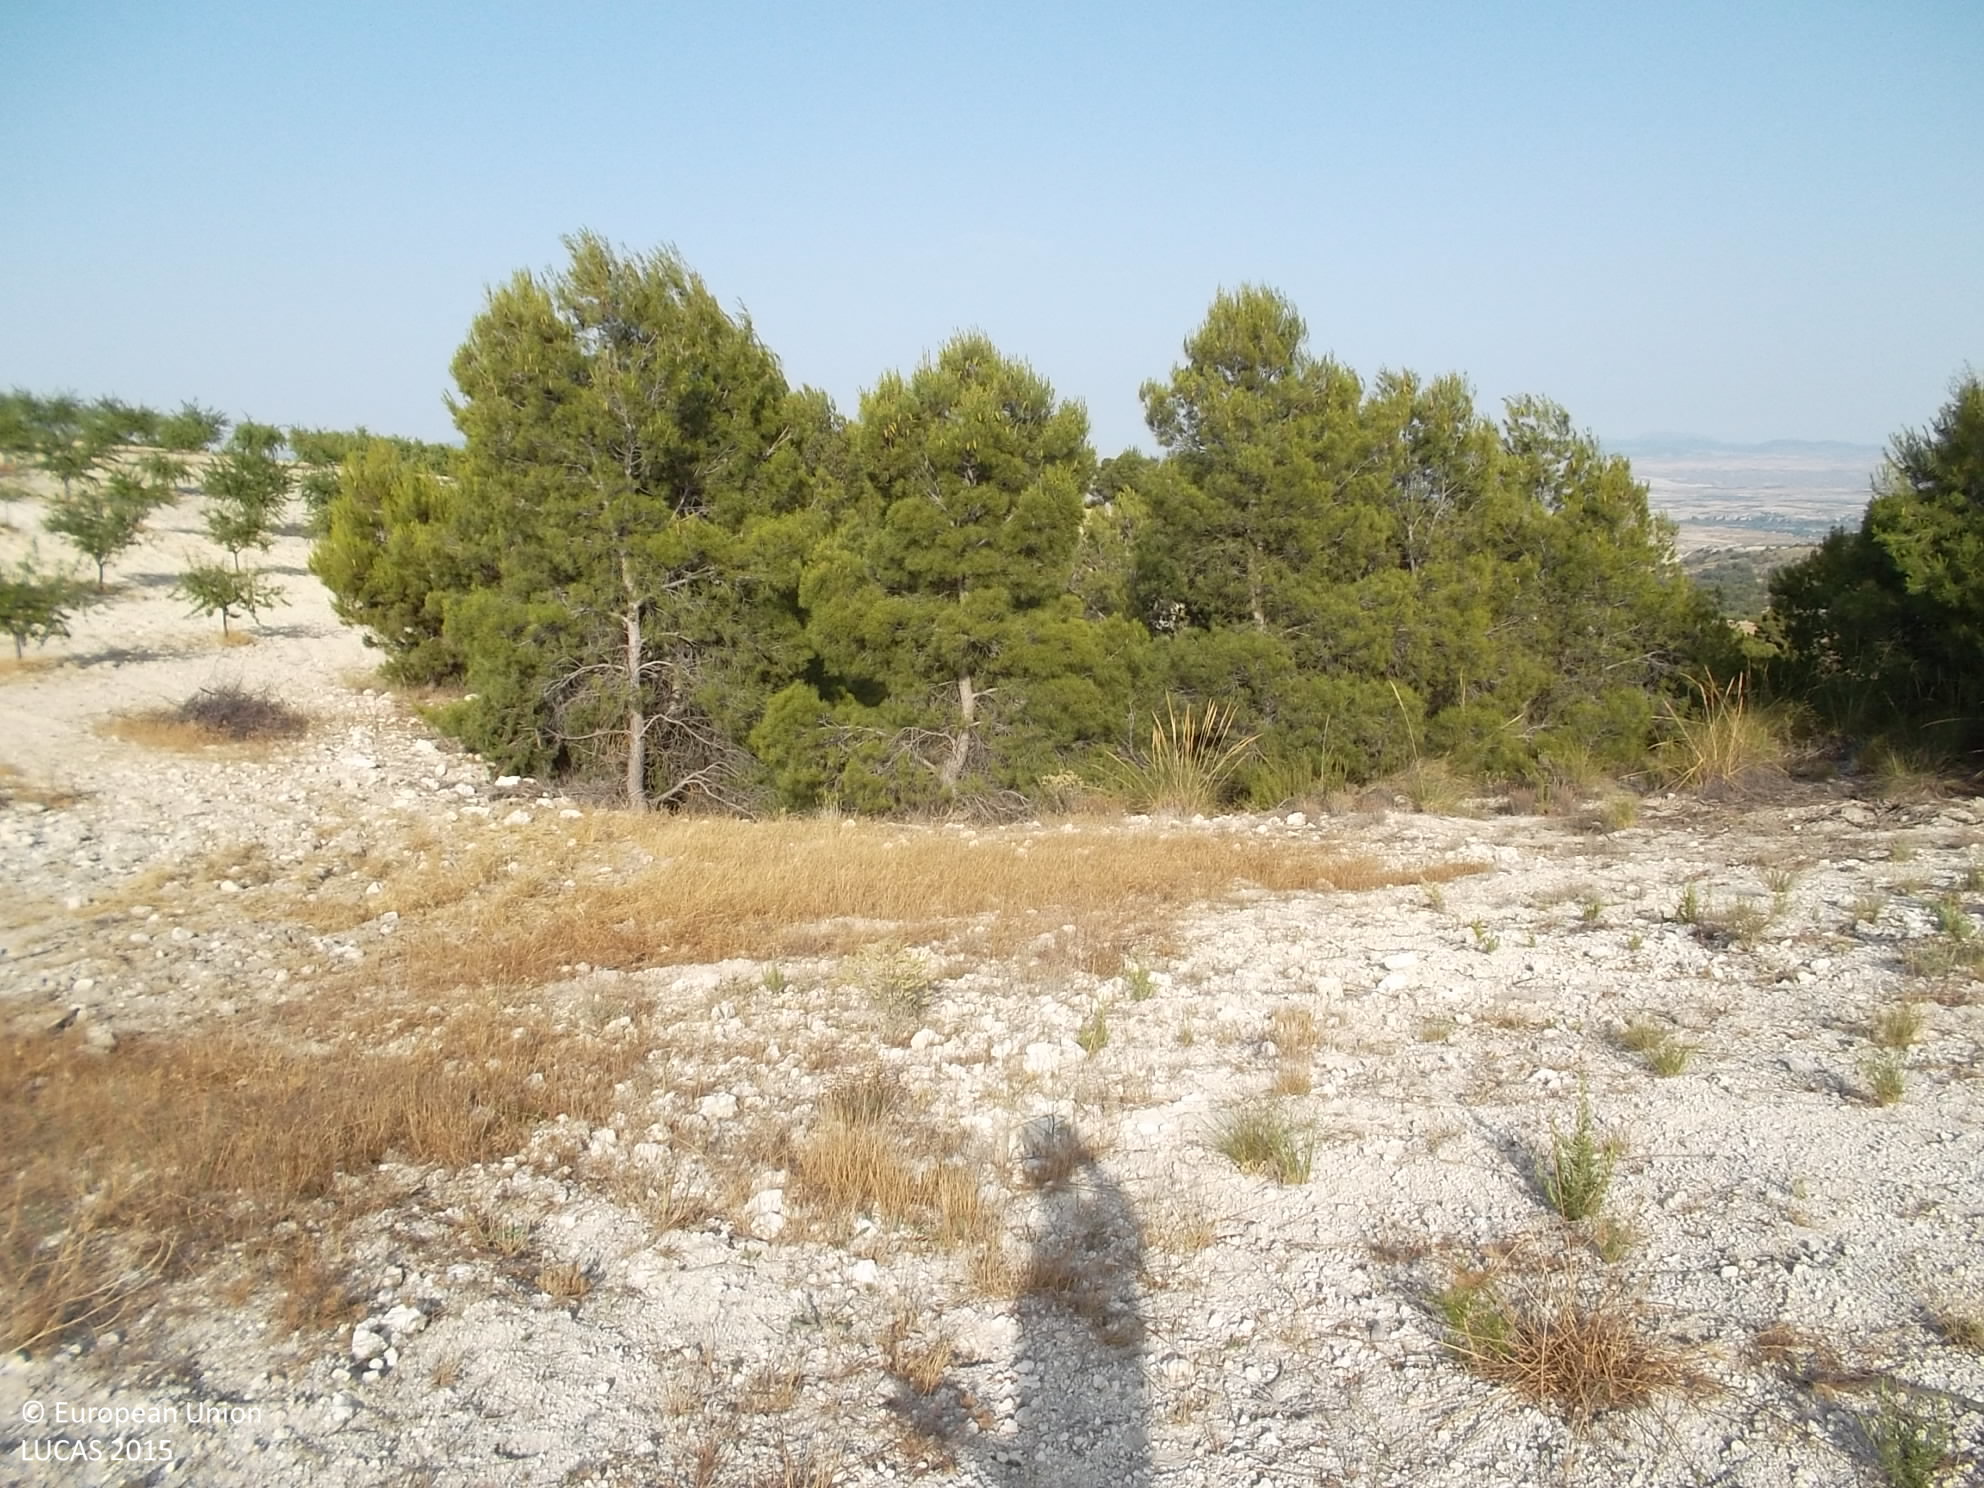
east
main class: Grassland
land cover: Grassland without tree/shrub cover
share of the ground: 25 - 50 %
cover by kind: herbaceous plants 60 %, unconsolidated bare surface 40 %
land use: Agriculture (excluding fallow land and kitchen gardens)
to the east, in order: Grassland without tree/shrub cover; Pine dominated coniferous woodland; Grass margins; Nuts trees
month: June
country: ES
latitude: 37.6446
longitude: -2.8306
